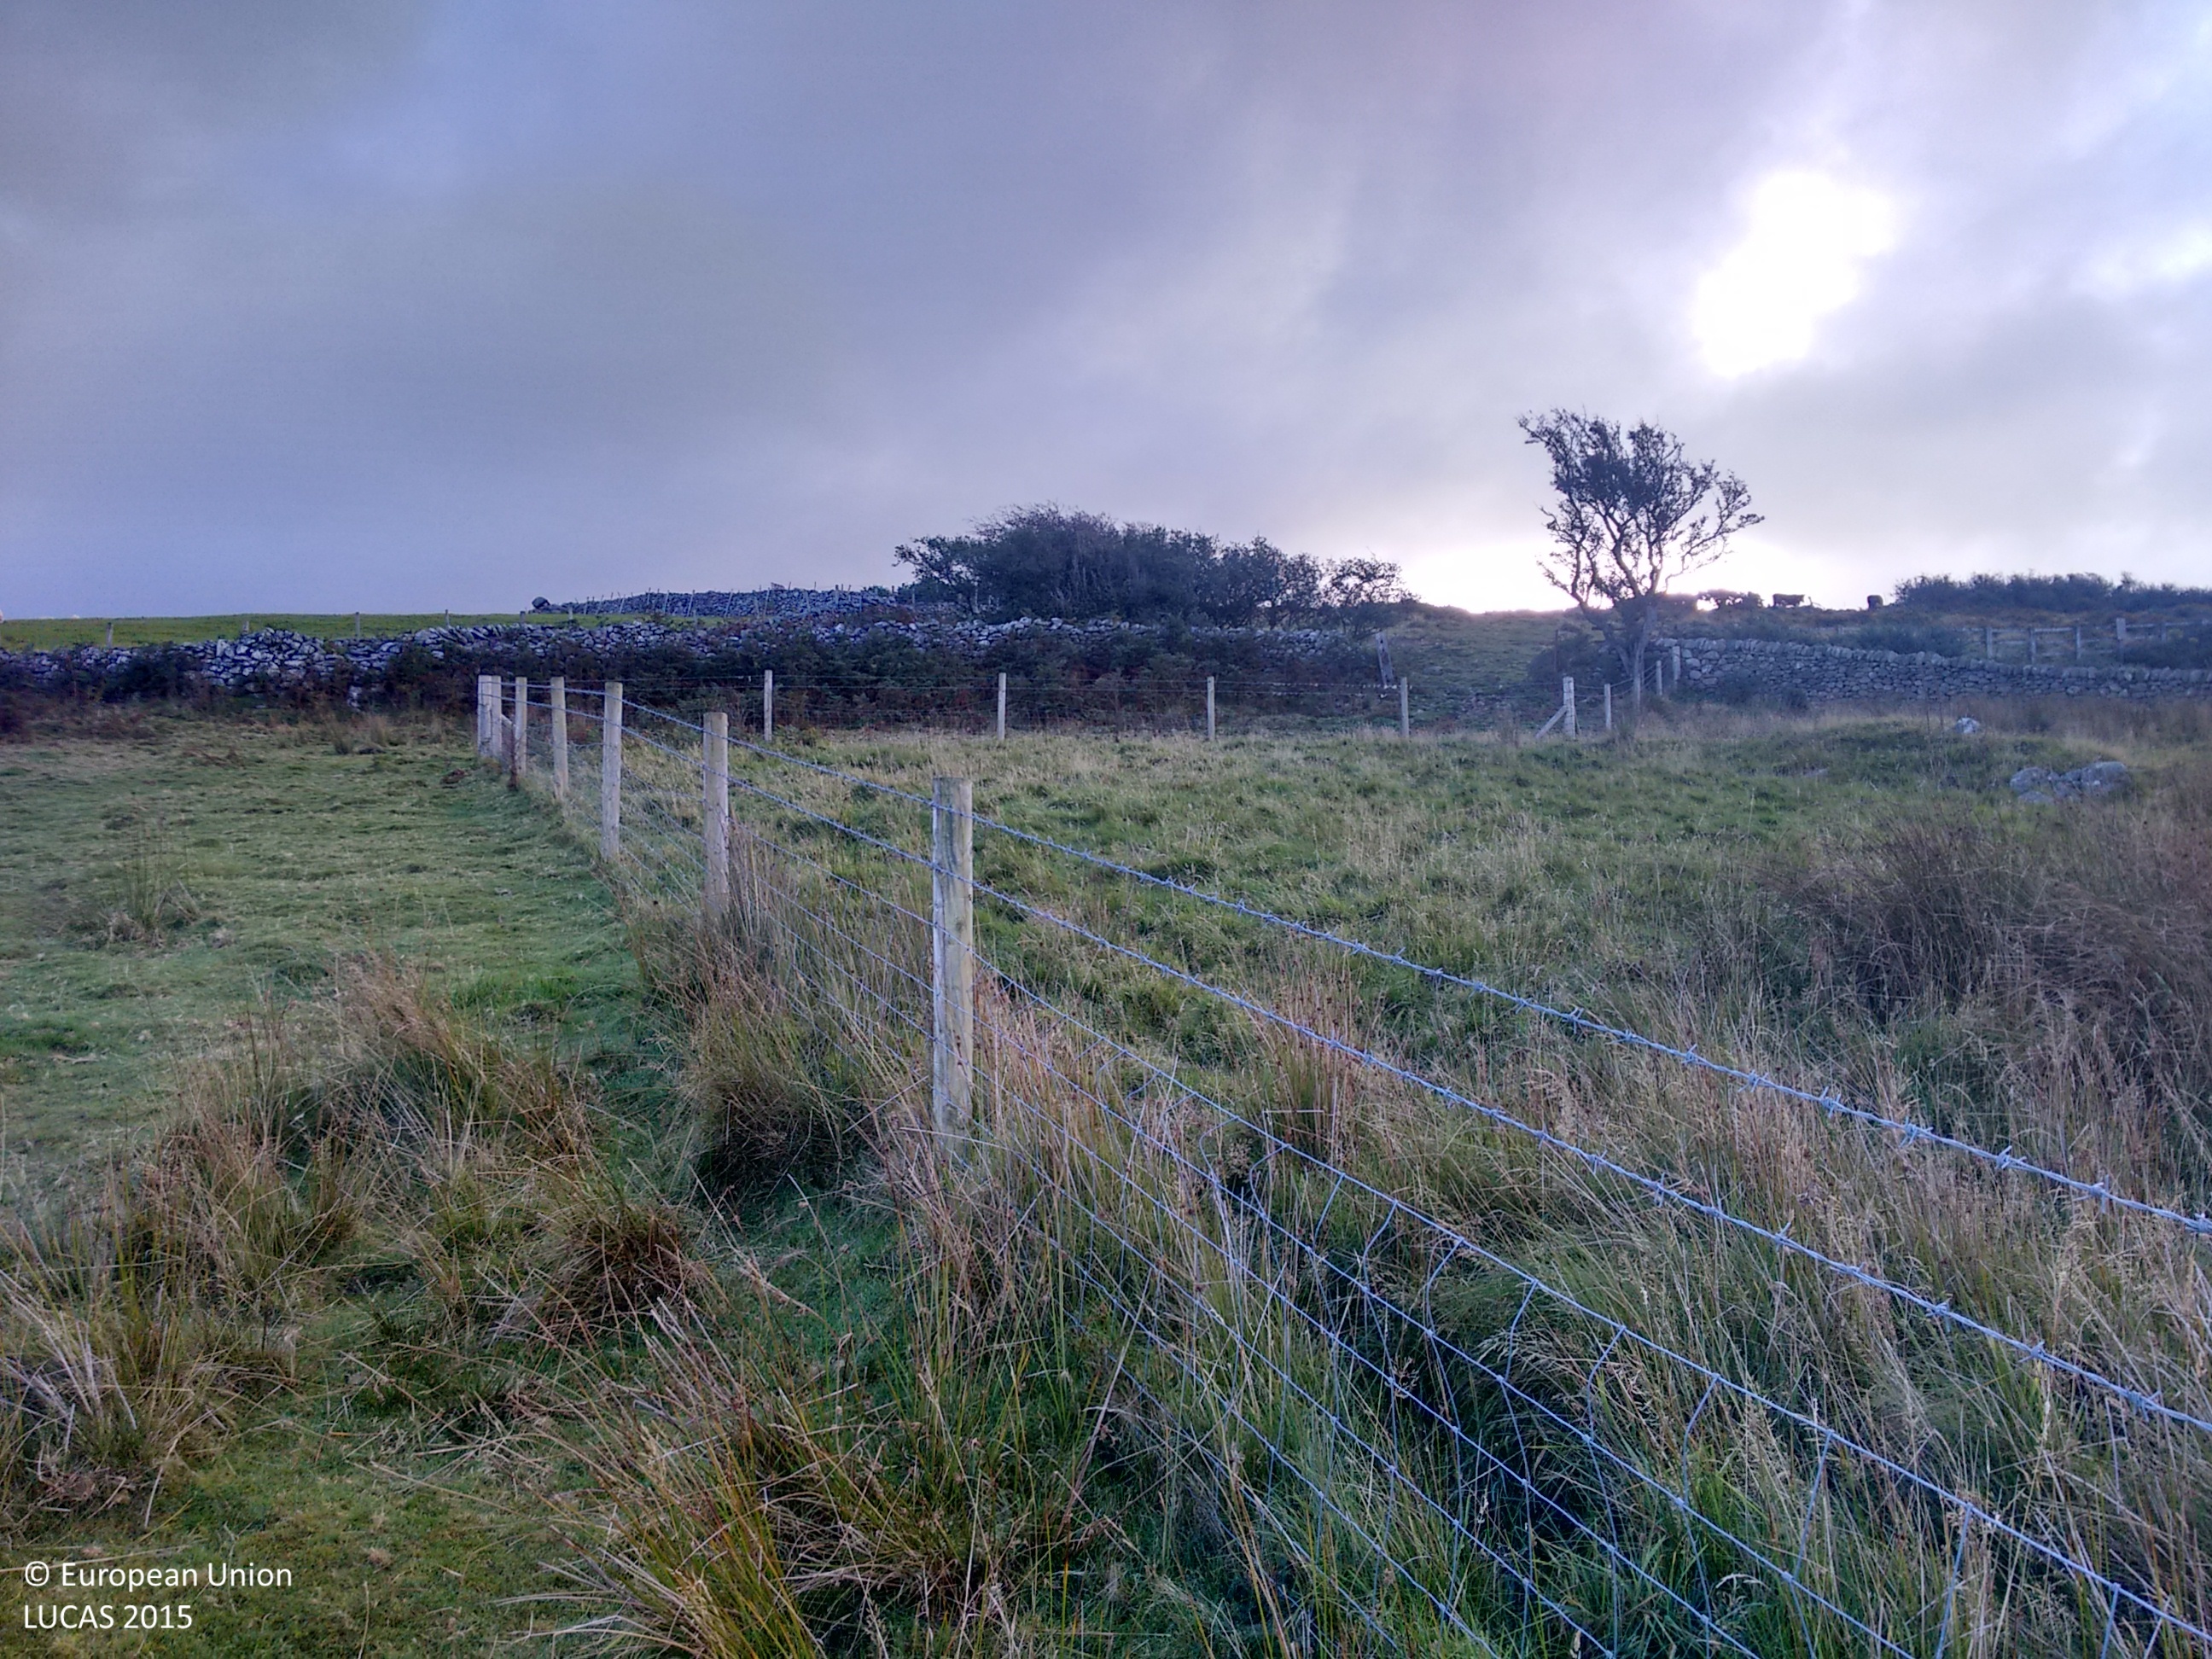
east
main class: Grassland
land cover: Grassland without tree/shrub cover
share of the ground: > 75 %
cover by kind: herbaceous plants 100 %
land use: Agriculture (excluding fallow land and kitchen gardens)
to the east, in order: Grassland without tree/shrub cover; Fences; Grassland without tree/shrub cover; Fences; Grassland without tree/shrub cover; Dry stone walls; Tracks; Dry stone walls; Grassland without tree/shrub cover; Ditches and canals; Dry stone walls; Tracks; Dry stone walls; Grassland without tree/shrub cover; Dry stone walls; Tracks; Dry stone walls; Grassland without tree/shrub cover
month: October
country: GB
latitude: 52.7752
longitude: -4.0747
